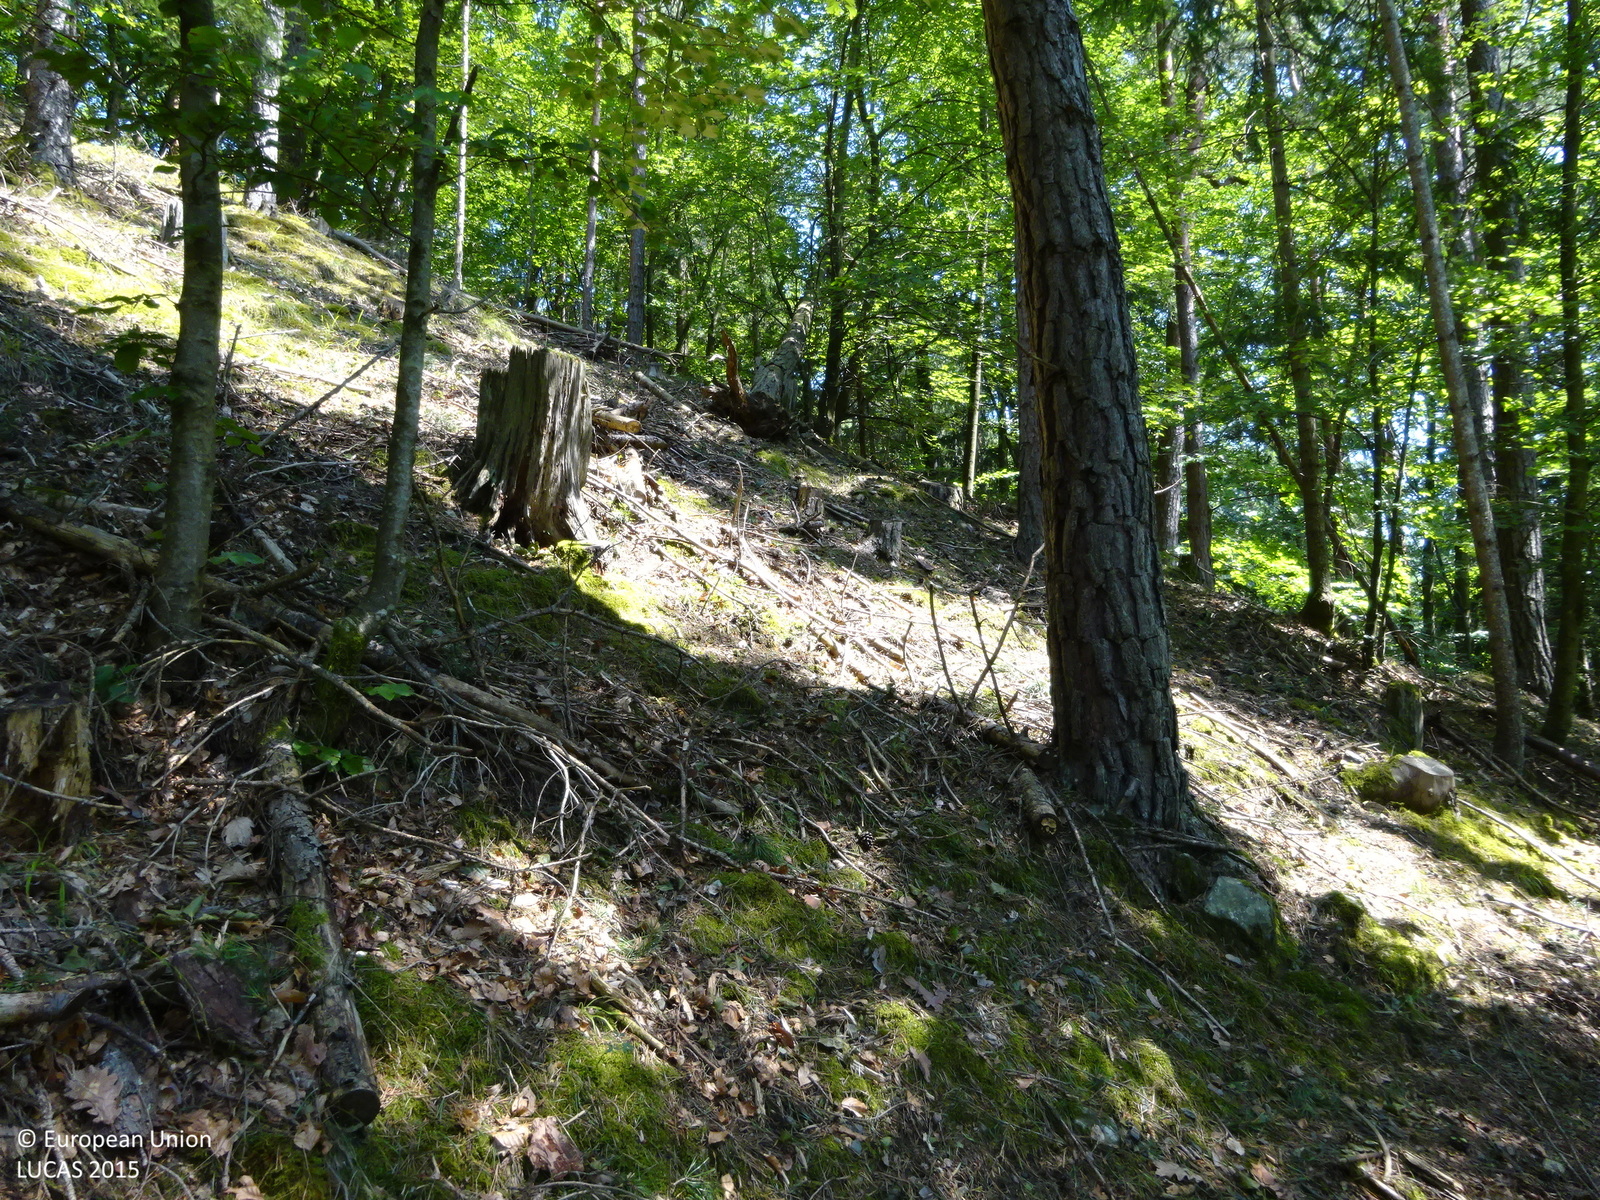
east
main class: Woodland
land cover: Pine dominated mixed woodland
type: hemiboreal forest and nemoral coniferous forest and mixed broadleaved-coniferous forest
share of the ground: > 75 %
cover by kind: coniferous forest trees 45 %, broadleaved forest trees 45 %, lichens and mosses 5 %, unconsolidated bare surface 5 %
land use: Forestry
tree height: > 5 m
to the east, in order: Pine dominated mixed woodland; Broadleaved woodland; Other bare soil; Tracks; Broadleaved woodland; Tracks; Spruce dominated mixed woodland; Rivers and streams; Spruce dominated mixed woodland
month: July
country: AT
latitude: 47.2857
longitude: 15.2754
